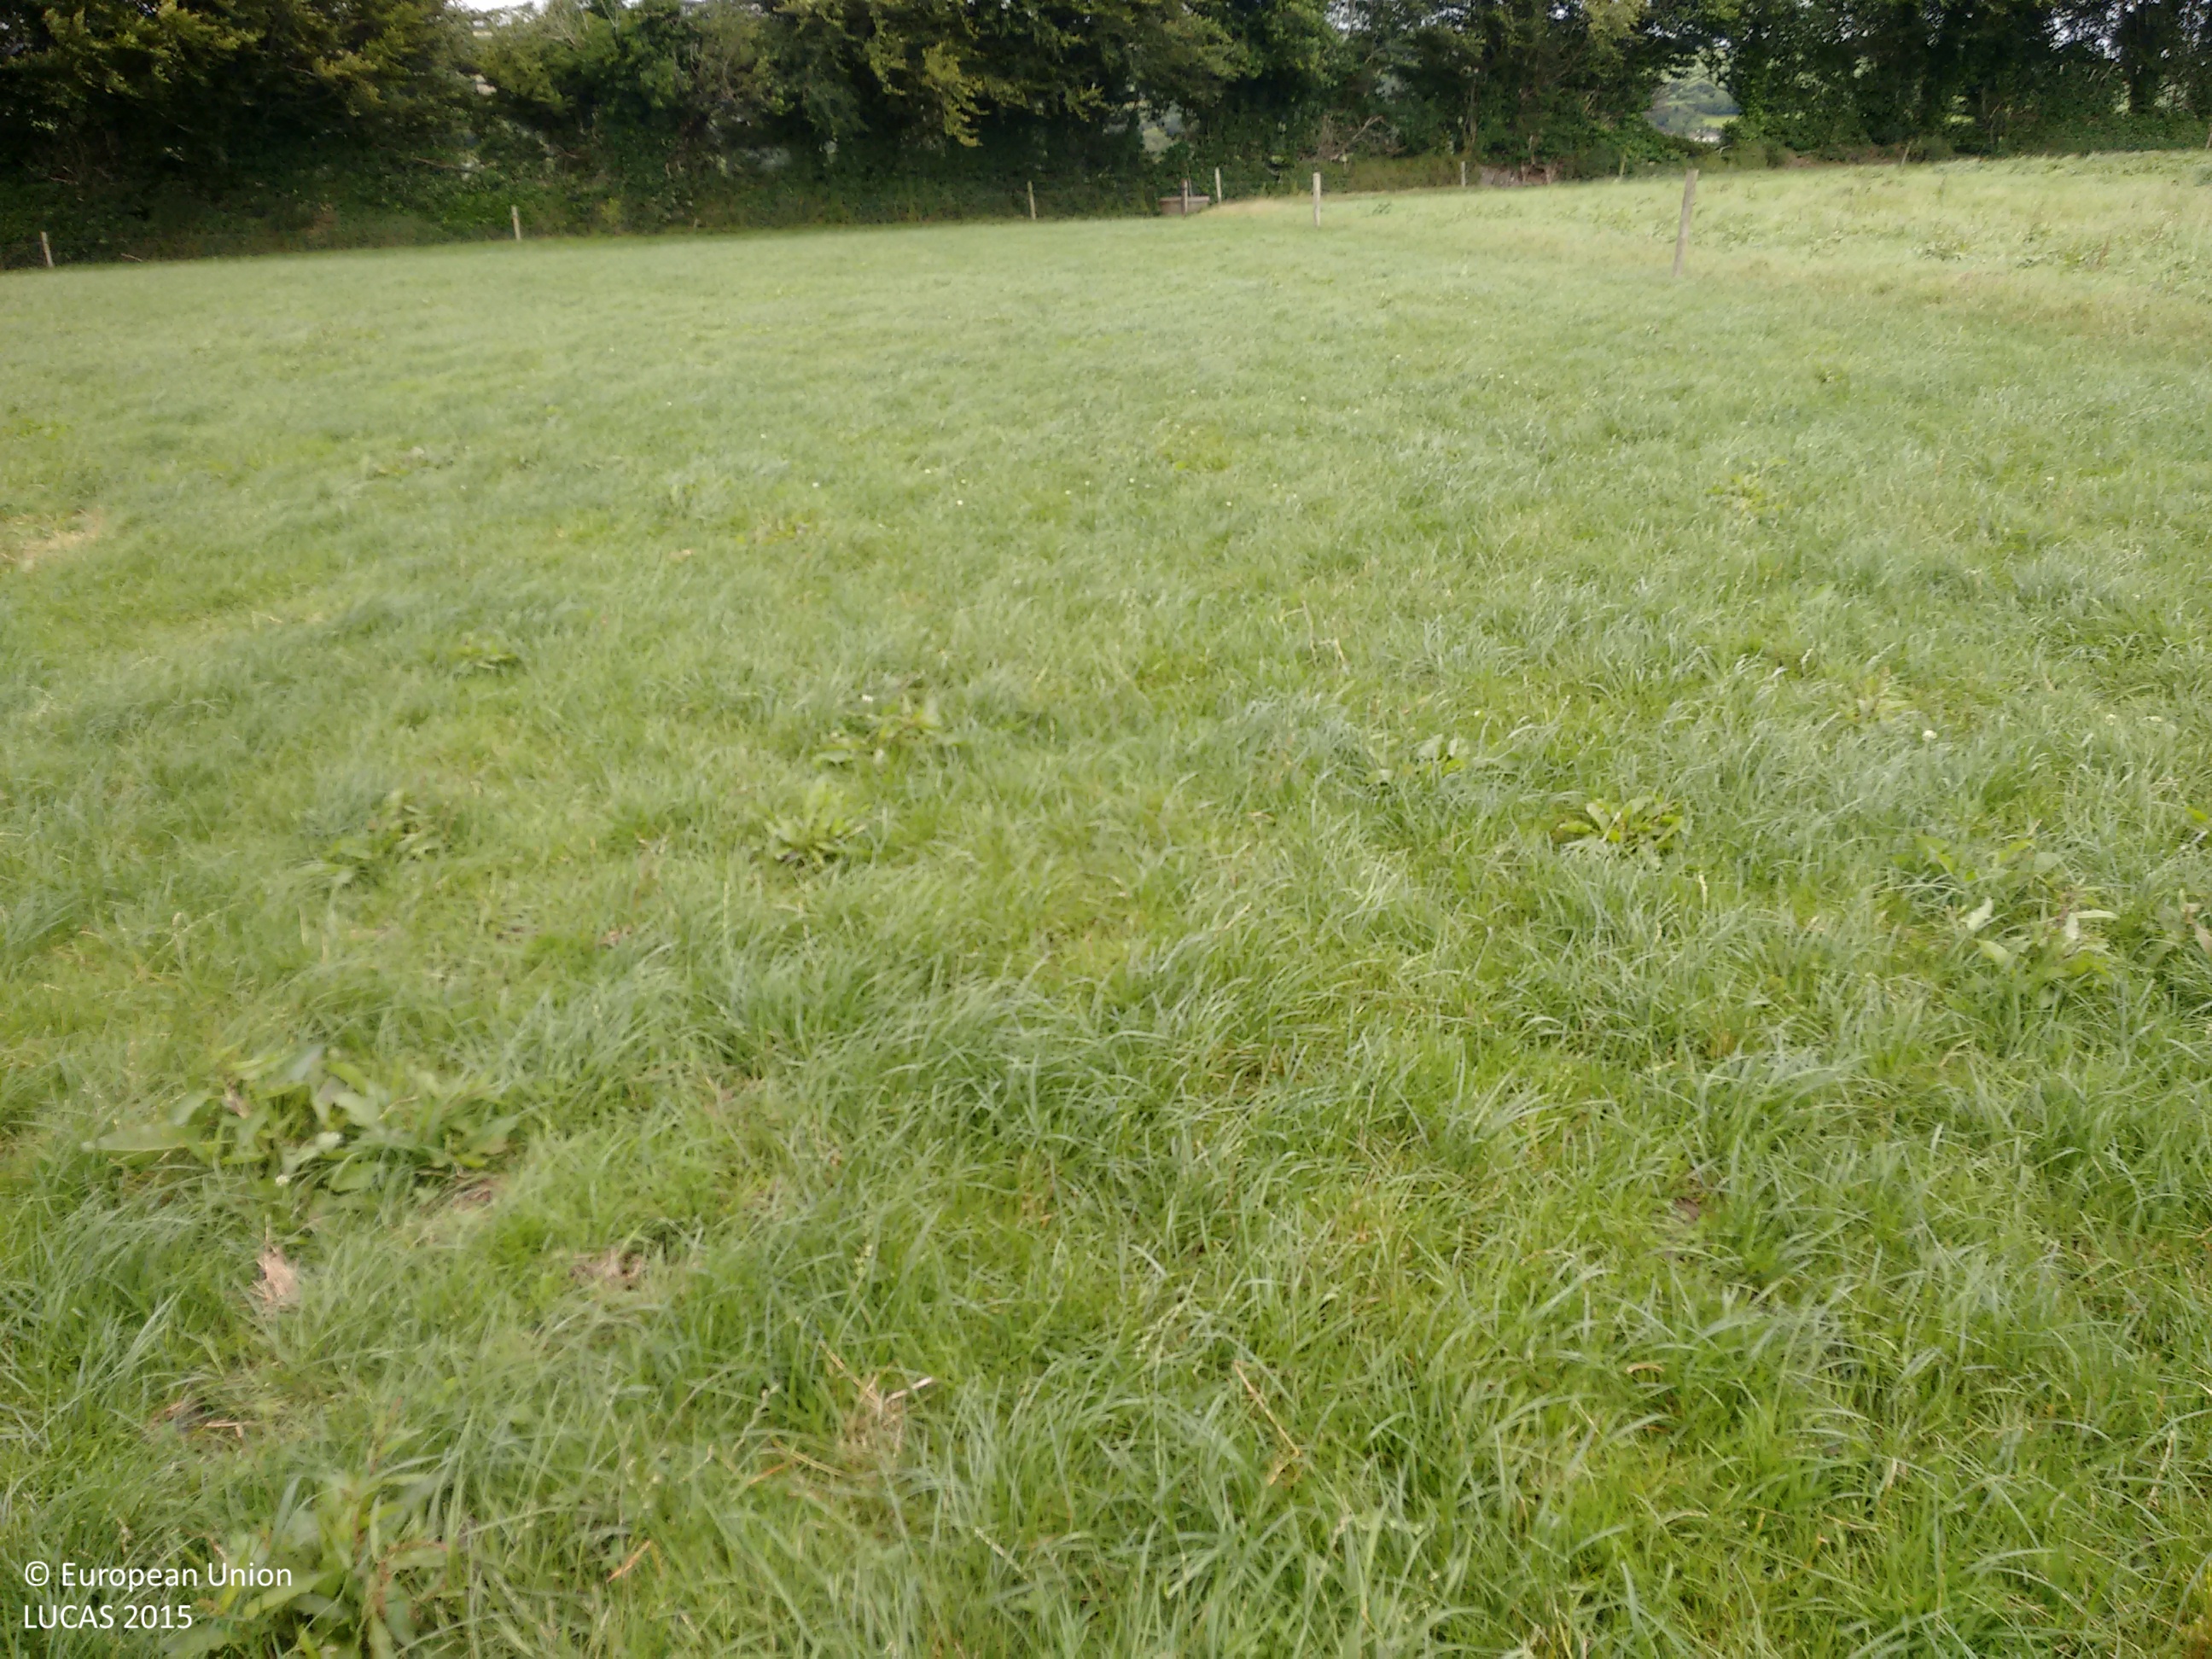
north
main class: Grassland
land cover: Grassland without tree/shrub cover
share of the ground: > 75 %
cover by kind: herbaceous plants 100 %
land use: Agriculture (excluding fallow land and kitchen gardens)
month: July
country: IE
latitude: 52.1692
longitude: -8.2114
